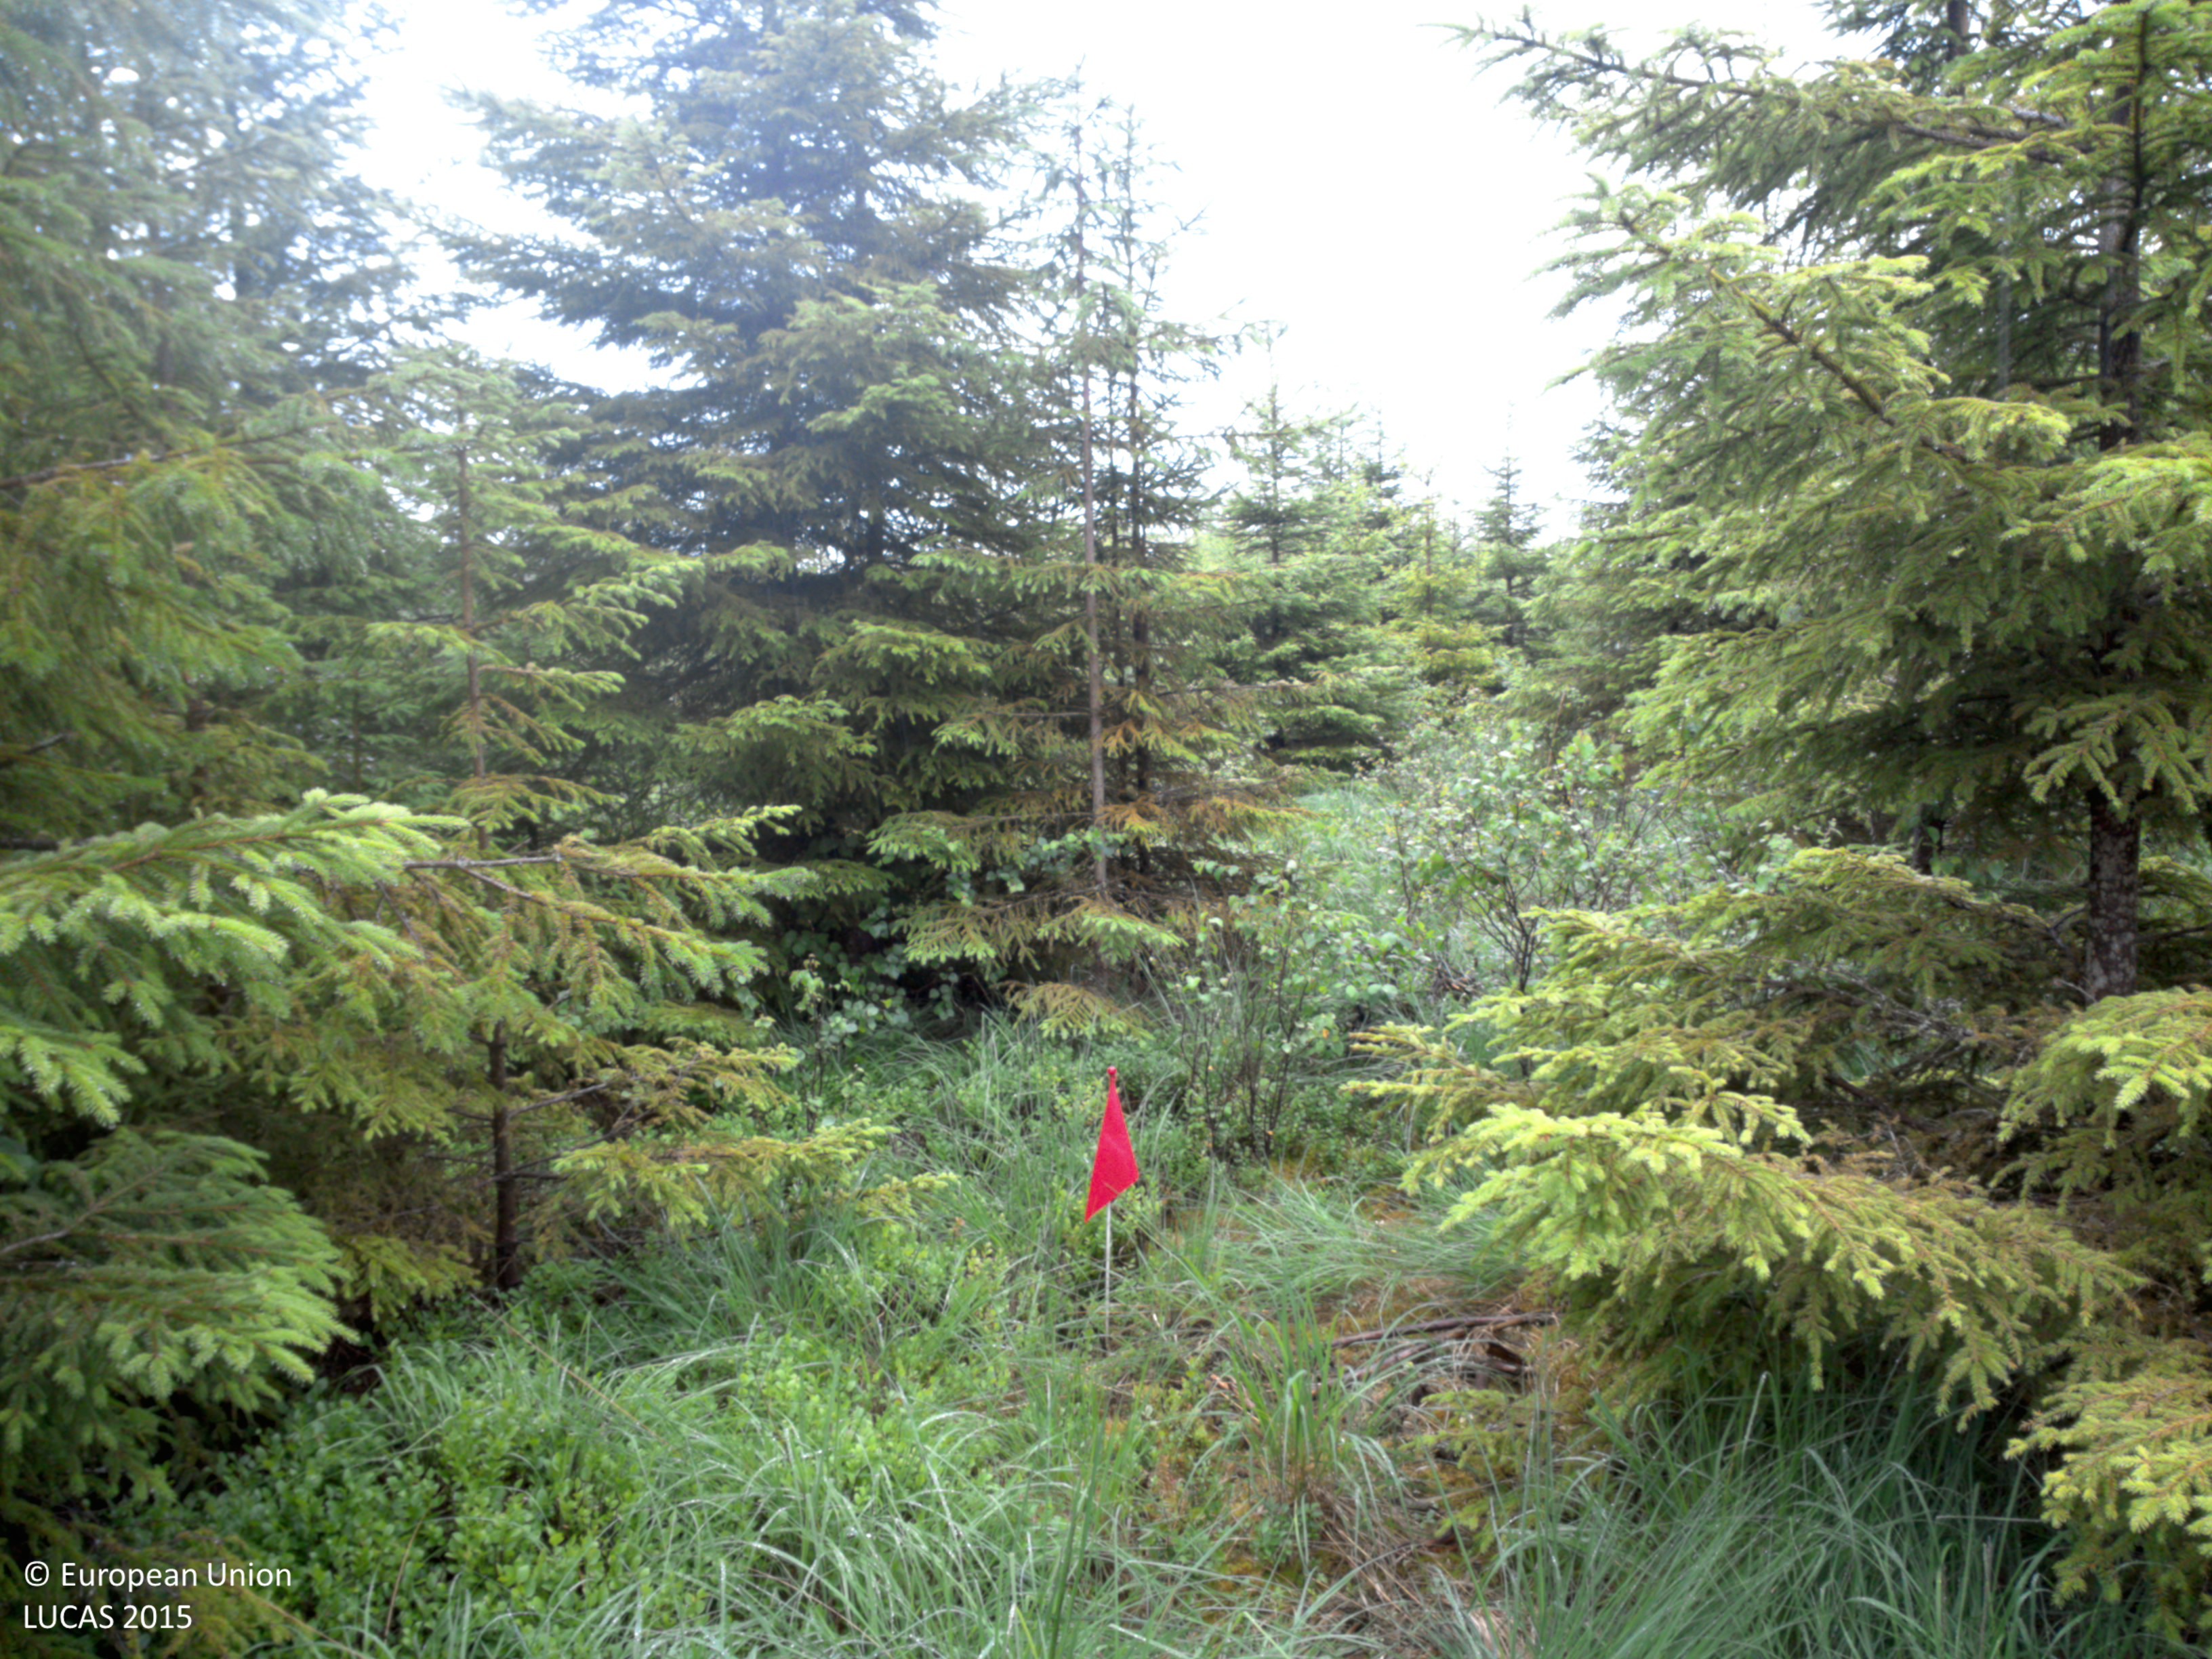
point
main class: Woodland
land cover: Spruce dominated mixed woodland
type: boreal forest
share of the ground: 50 - 75 %
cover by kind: coniferous forest trees 40 %, shrubs 40 %, broadleaved forest trees 20 %
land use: Forestry
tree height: > 5 m
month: July
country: SE
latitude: 58.6597
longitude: 11.5996
